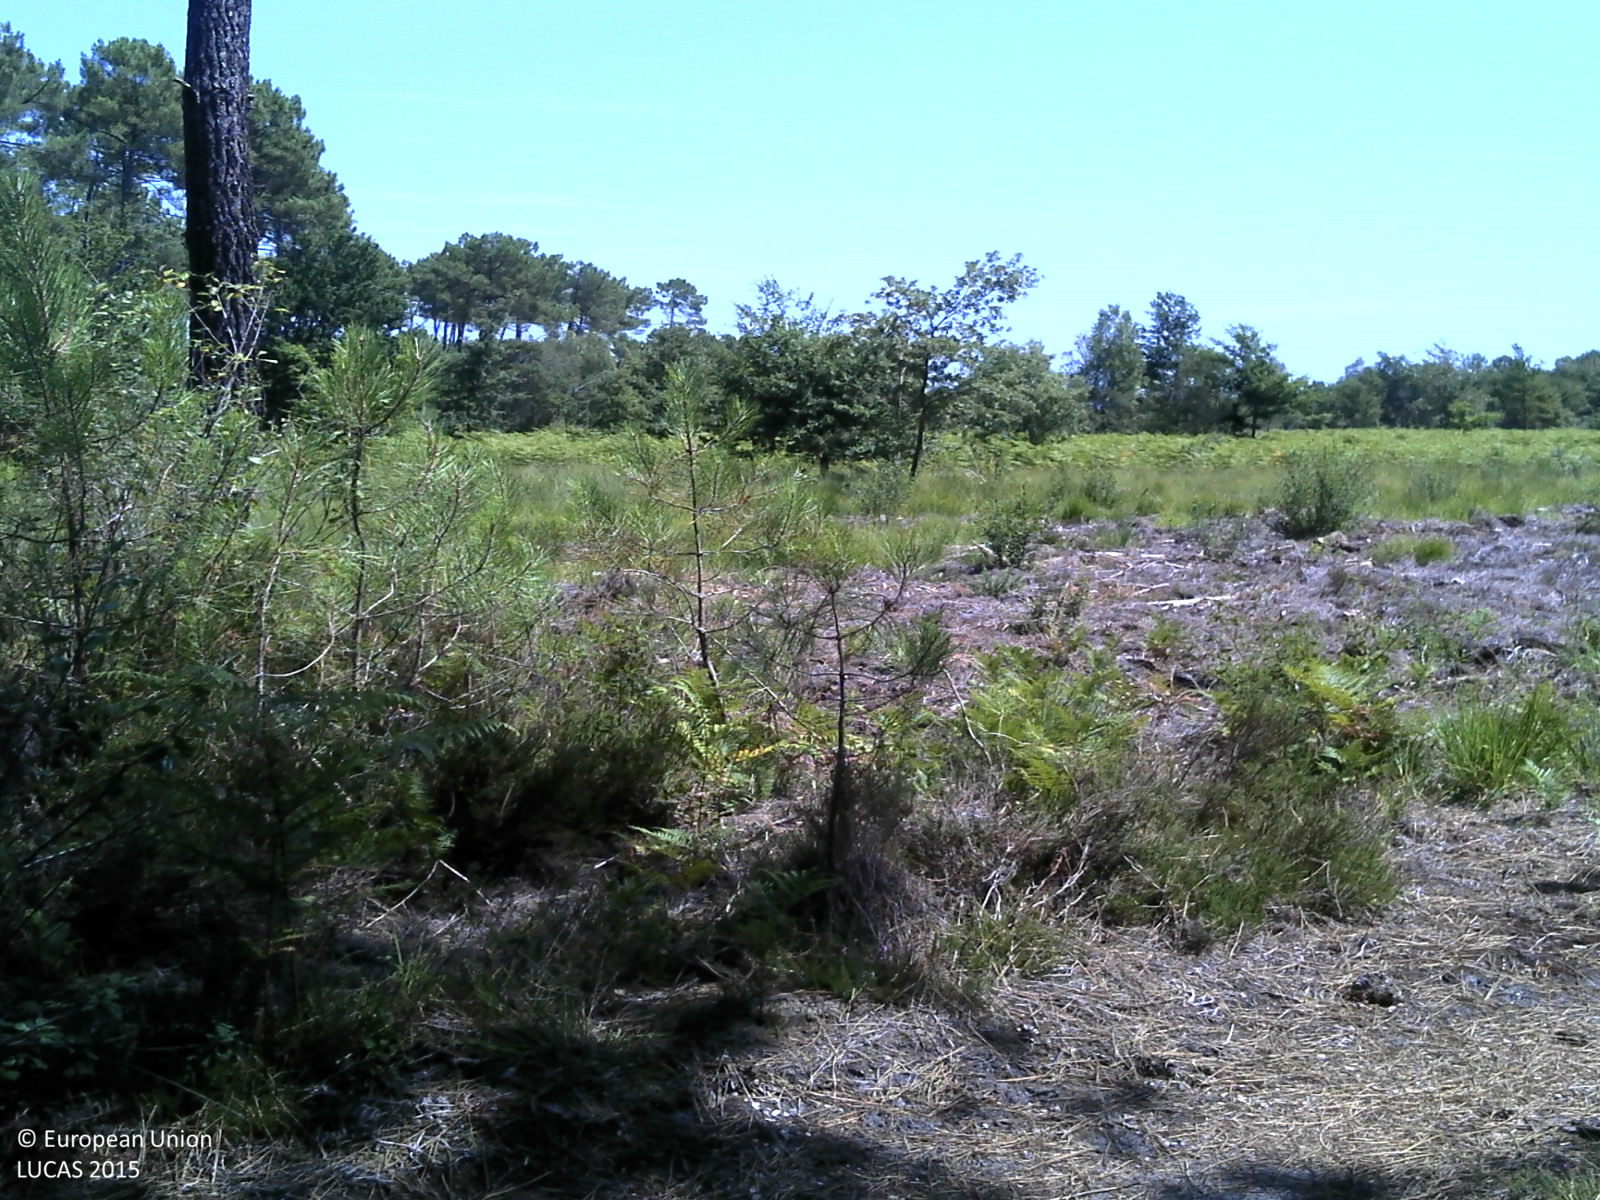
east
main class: Woodland
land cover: Pine dominated coniferous woodland
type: exotic forest
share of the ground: > 75 %
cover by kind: coniferous forest trees 60 %, shrubs 30 %, herbaceous plants 5 %, lichens and mosses 5 %
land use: Forestry
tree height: > 5 m
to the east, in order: Pine dominated coniferous woodland; Tracks; Pine dominated coniferous woodland; Pine dominated mixed woodland; Spontaneously vegetated surfaces
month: August
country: FR
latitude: 44.4822
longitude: -0.5651
